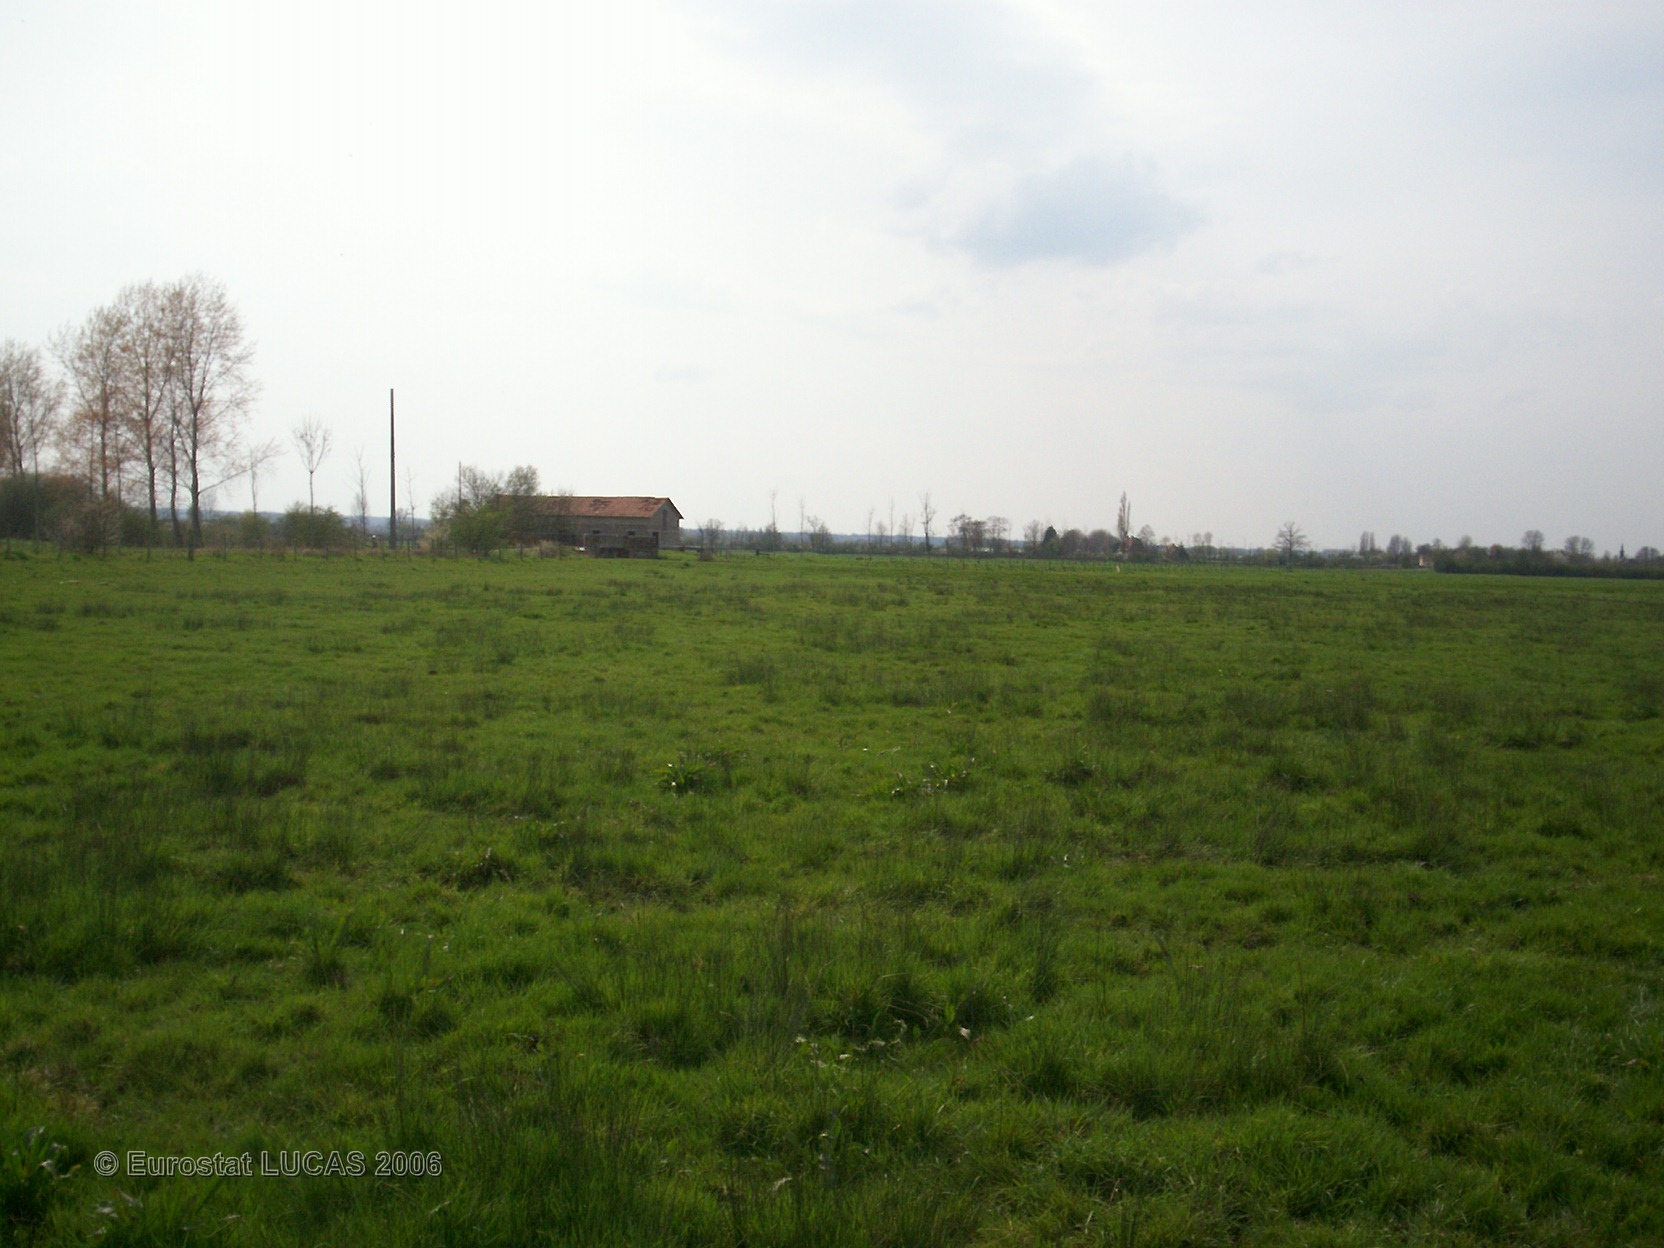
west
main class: Grassland
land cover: Grassland without tree/shrub cover
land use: Agriculture (excluding fallow land and kitchen gardens)
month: April
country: FR
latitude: 49.1254
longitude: -0.0209
